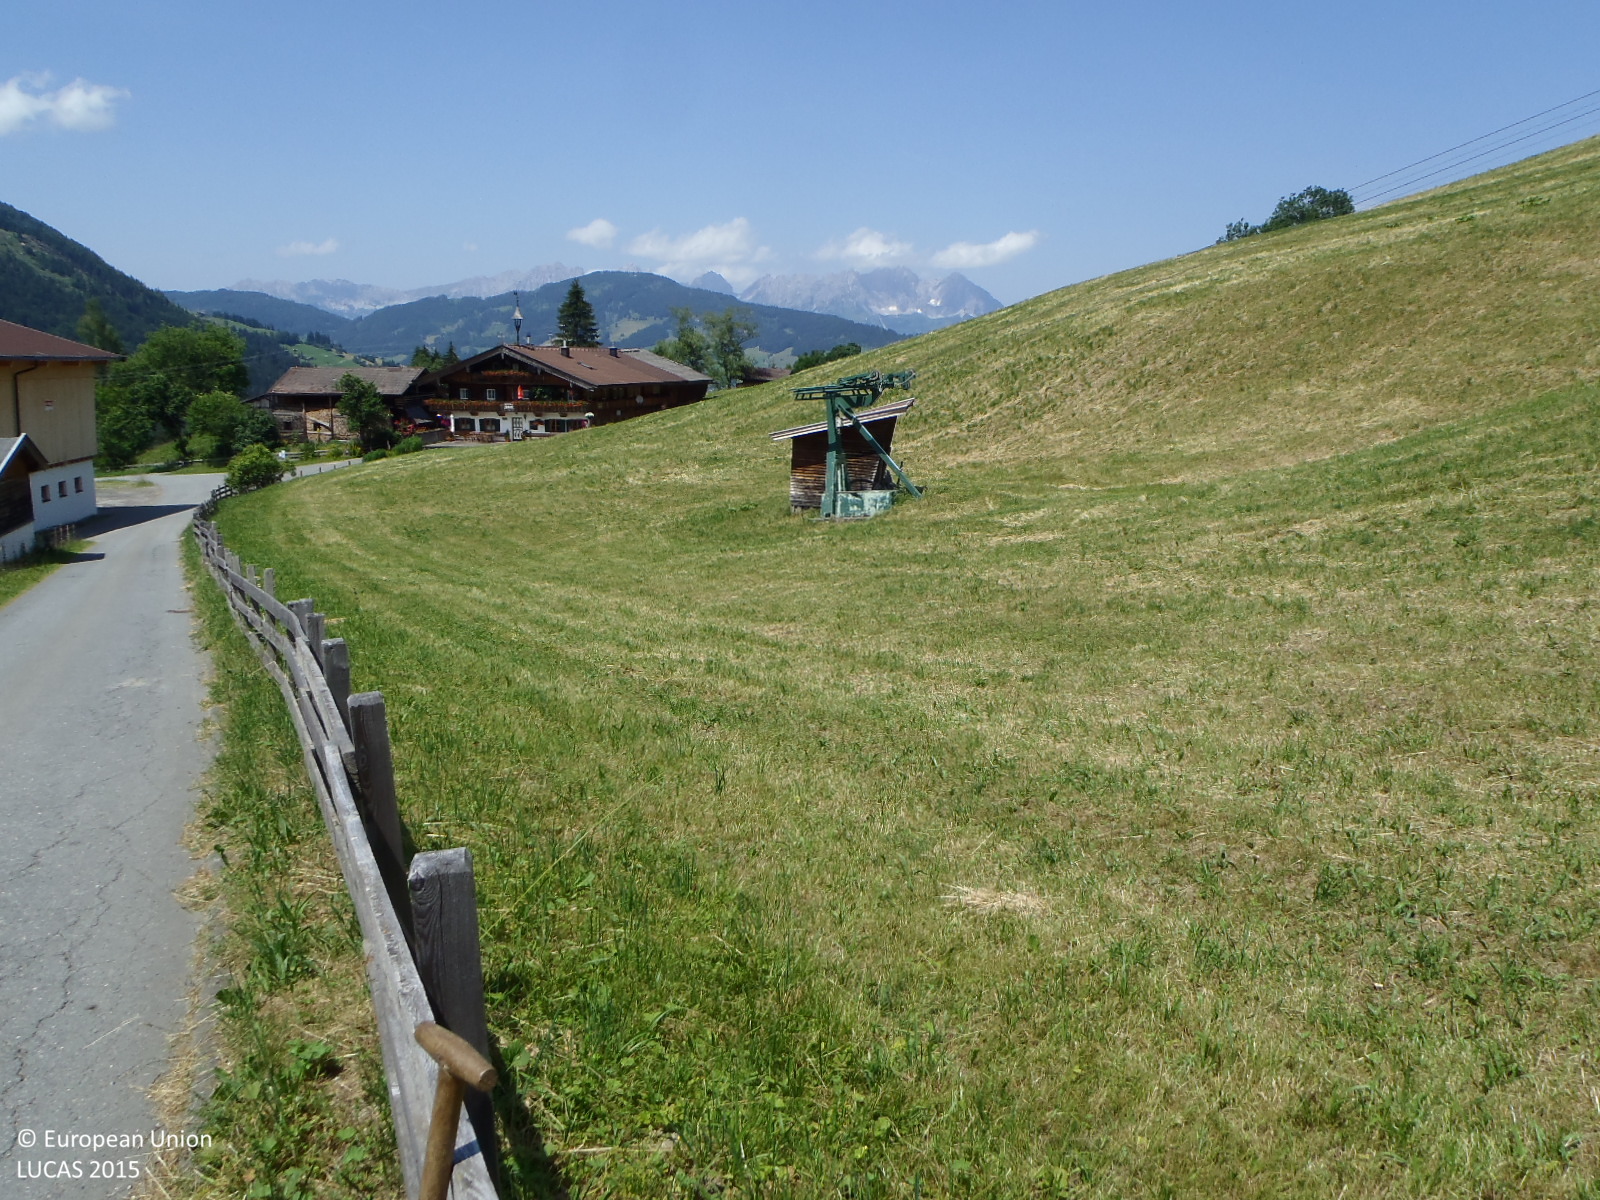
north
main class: Grassland
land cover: Grassland without tree/shrub cover
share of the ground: > 75 %
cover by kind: herbaceous plants 100 %
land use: Agriculture (excluding fallow land and kitchen gardens)
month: July
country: AT
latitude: 47.4070
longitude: 12.3174
